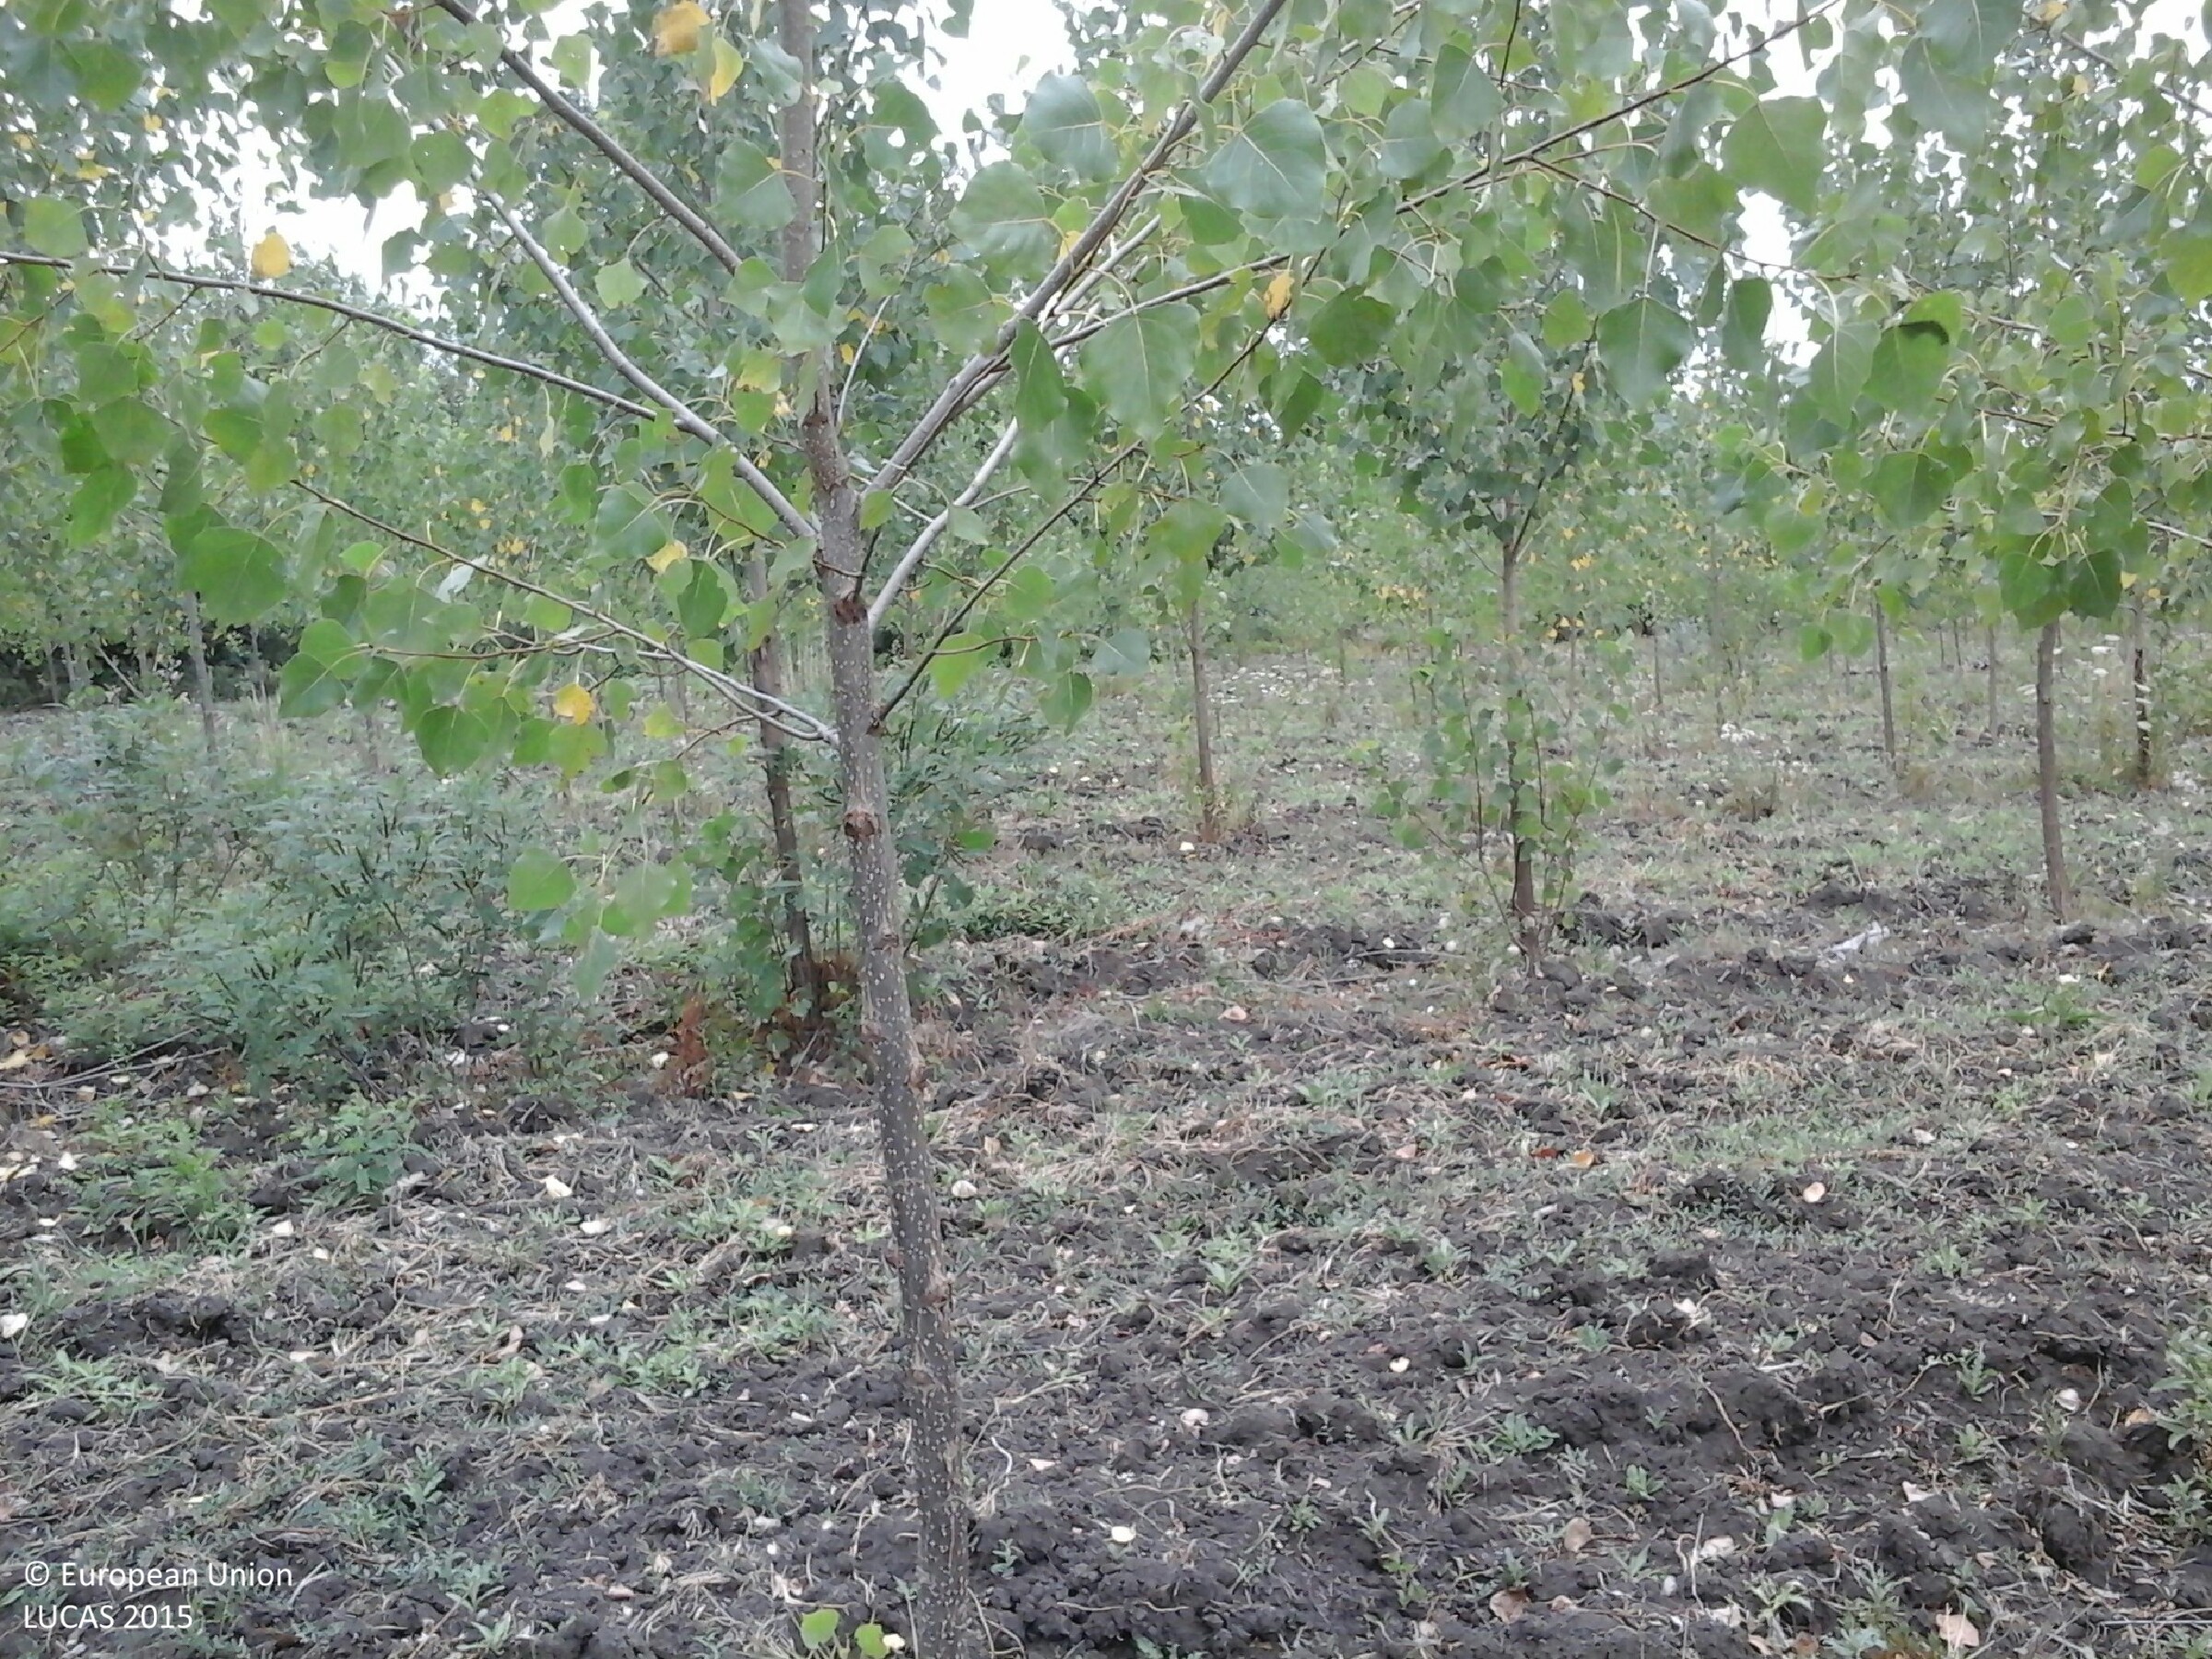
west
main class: Woodland
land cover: Broadleaved woodland
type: non-riverine alder, birch or aspen forest
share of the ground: 50 - 75 %
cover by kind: broadleaved forest trees 50 %, unconsolidated bare surface 35 %, herbaceous plants 15 %
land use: Forestry
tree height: < 5 m
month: July
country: HU
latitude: 47.4617
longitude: 20.5510
